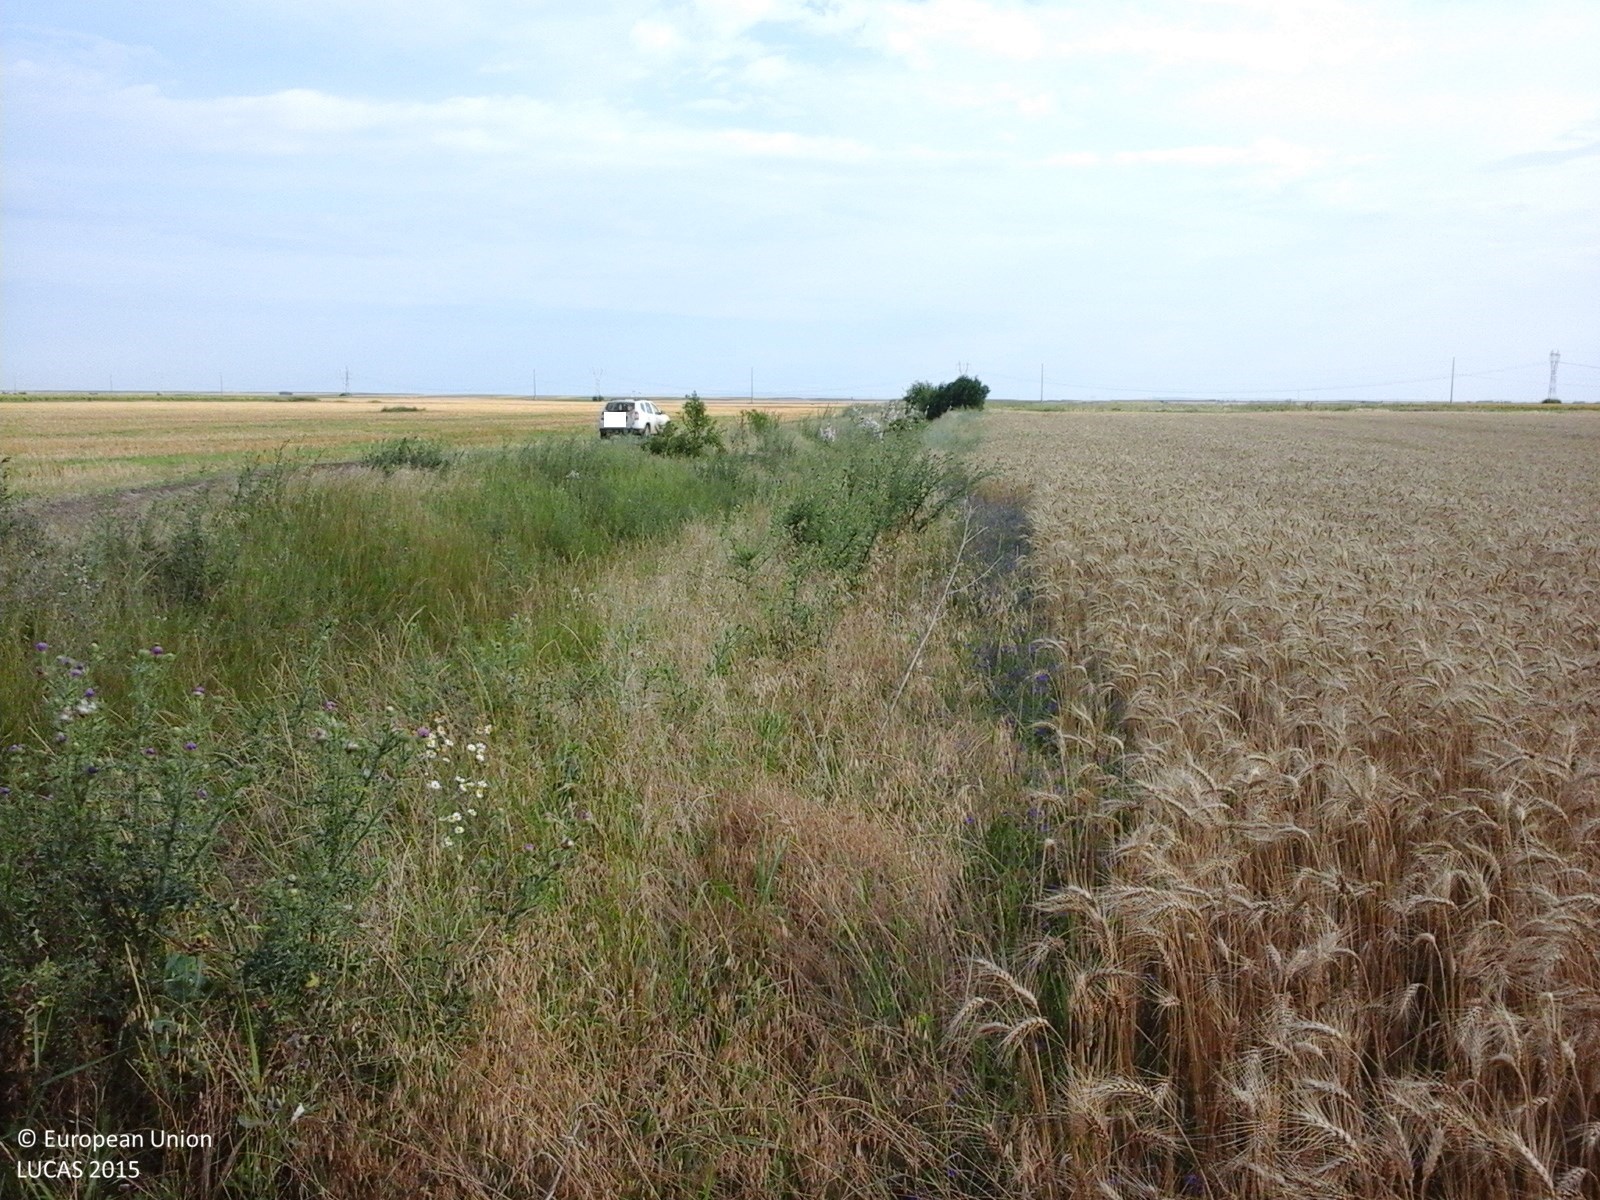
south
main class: Cropland
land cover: Common wheat
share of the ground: > 75 %
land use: Agriculture (excluding fallow land and kitchen gardens)
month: July
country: RO
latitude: 43.9152
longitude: 24.4735
